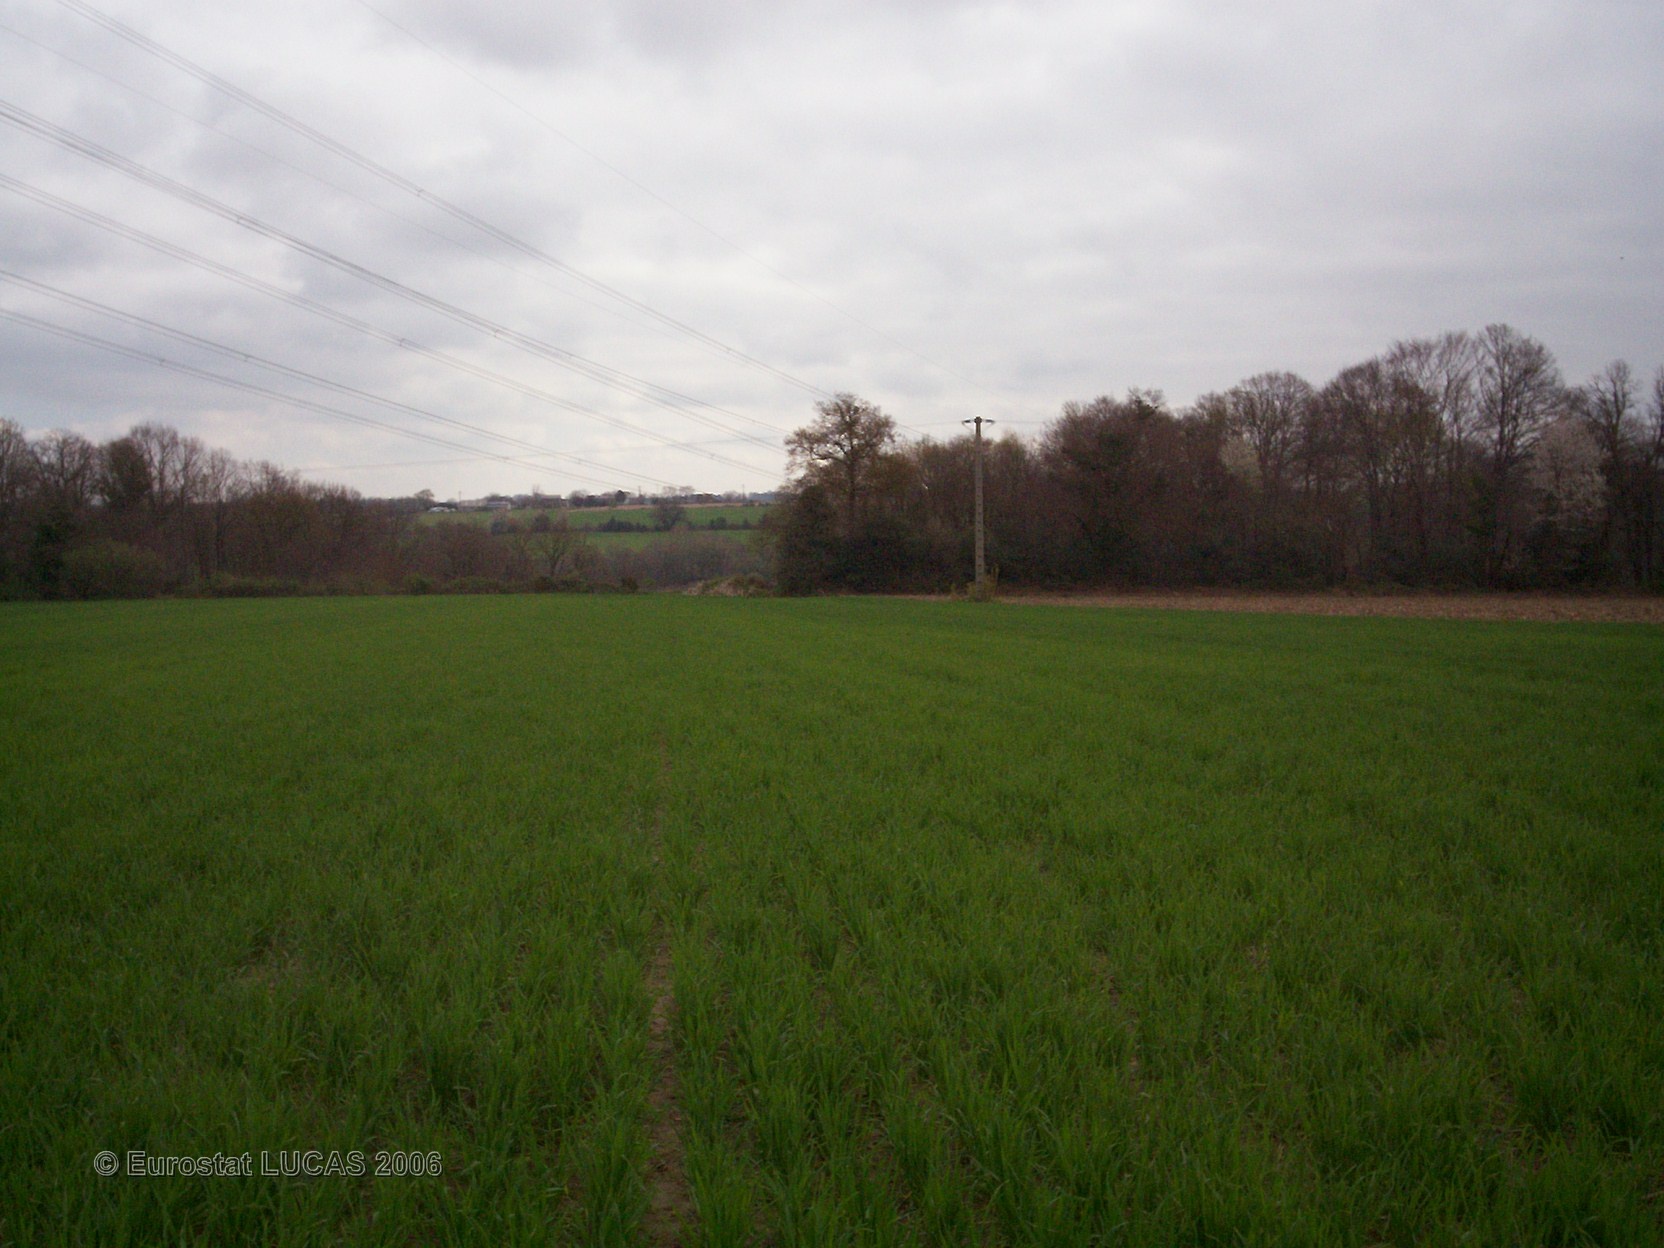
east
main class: Cropland
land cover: Triticale
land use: Agriculture (excluding fallow land and kitchen gardens)
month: April
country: FR
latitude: 43.3754
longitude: -0.1881
